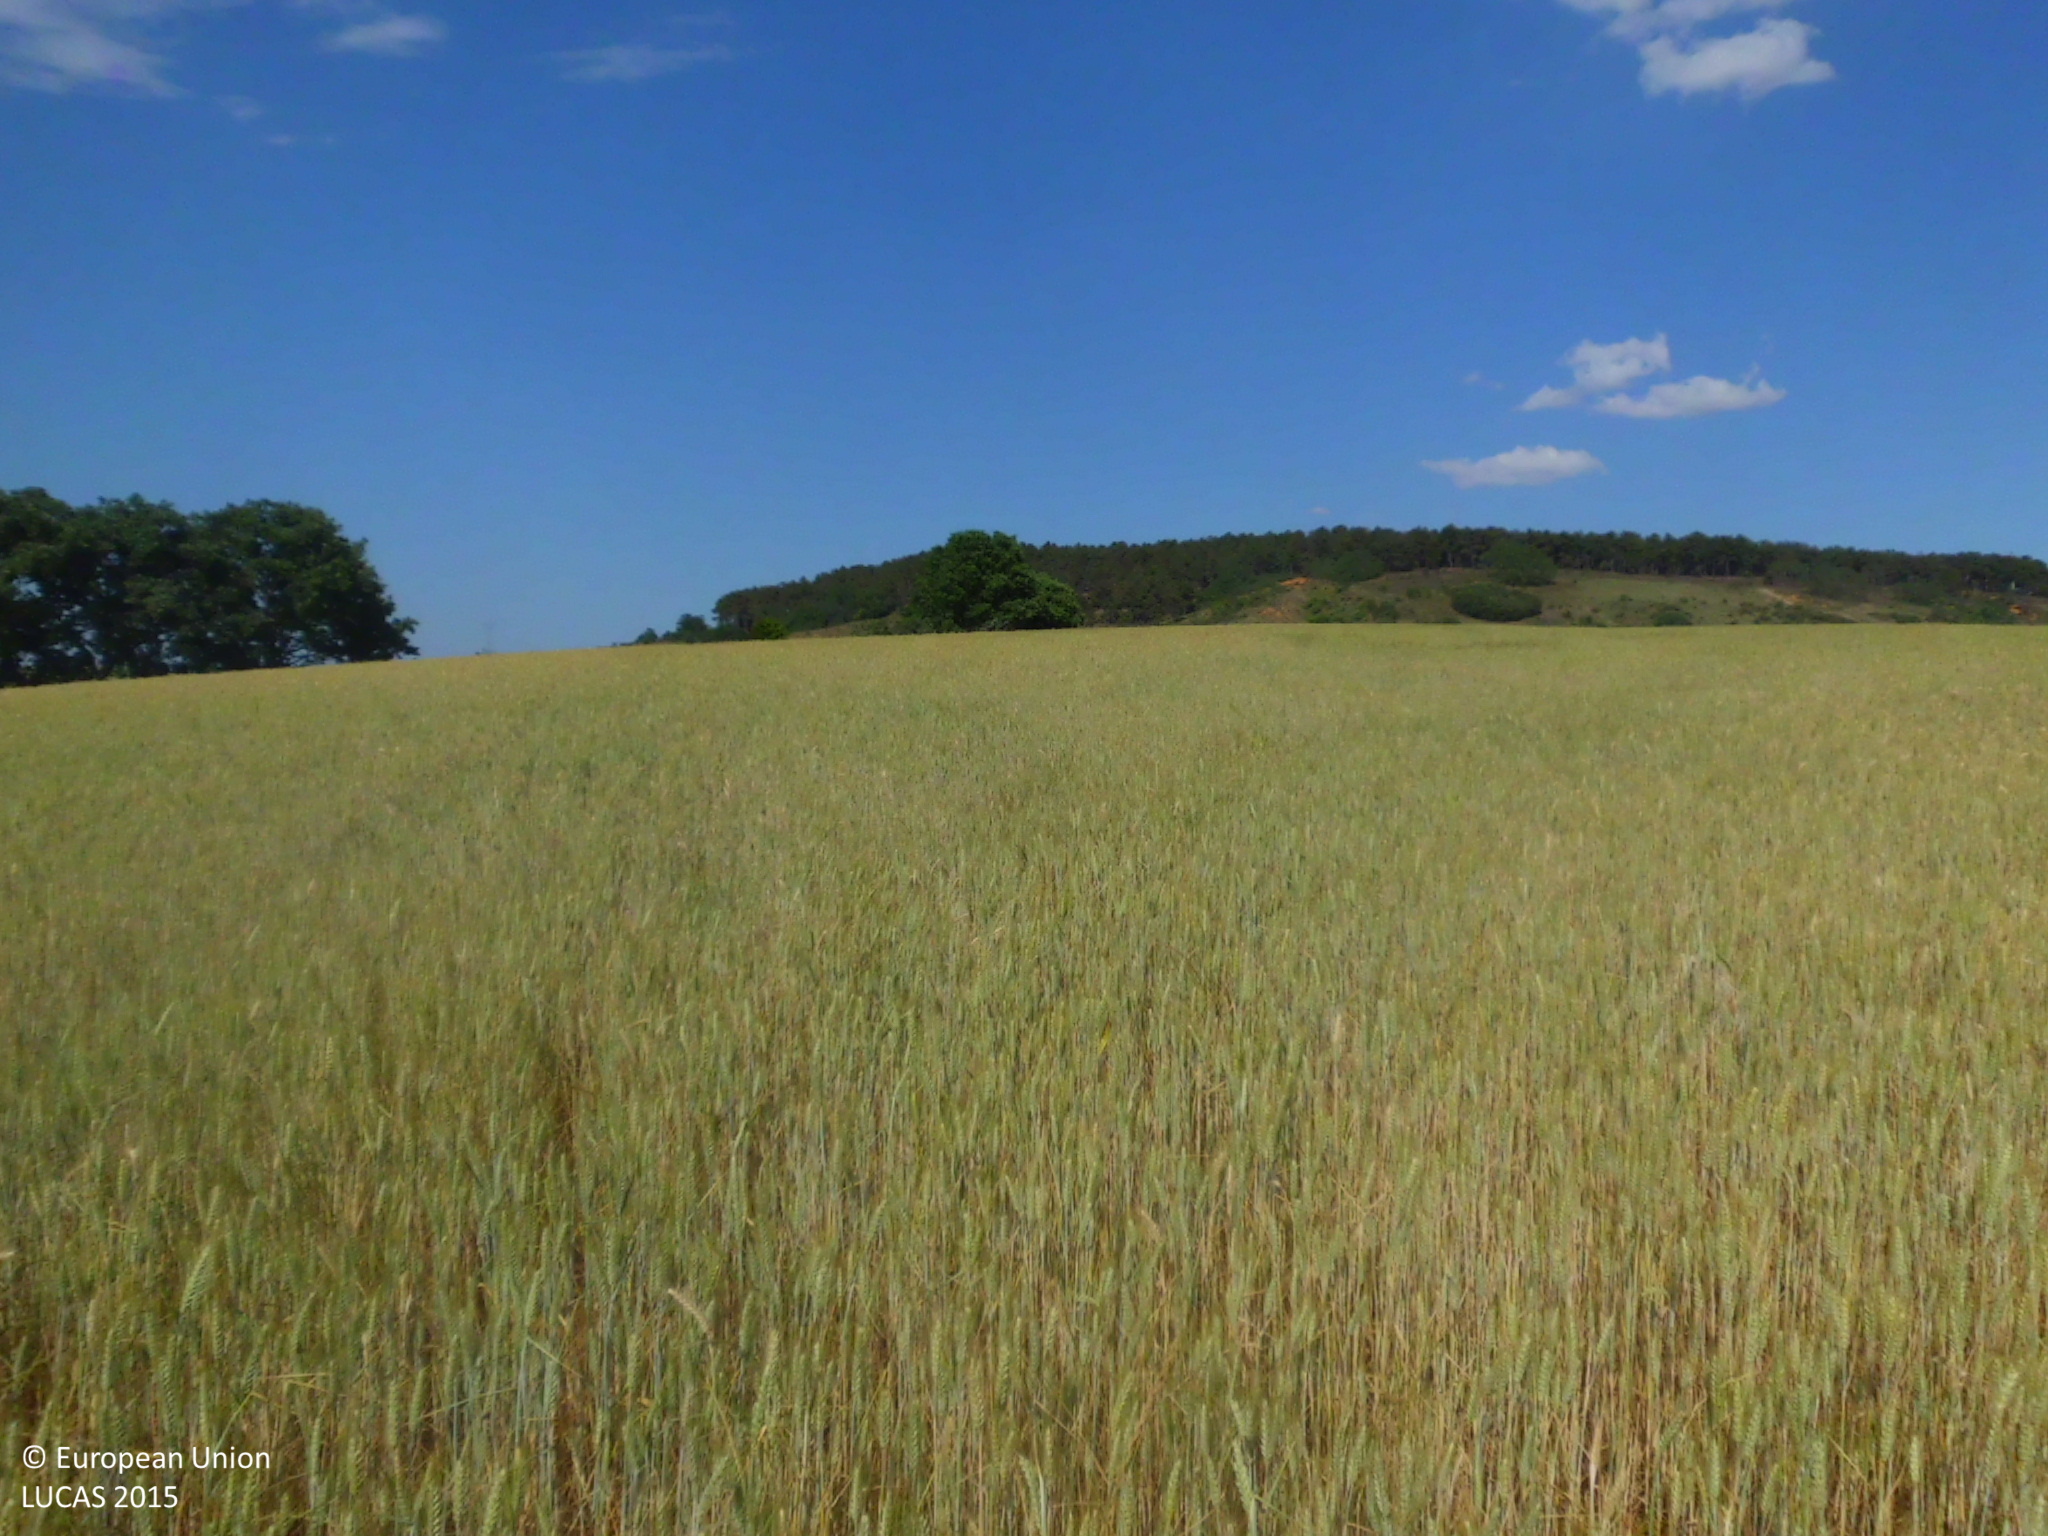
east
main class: Cropland
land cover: Common wheat
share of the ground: > 75 %
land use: Agriculture (excluding fallow land and kitchen gardens)
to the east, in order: Common wheat; Shrubland with sparse tree cover; Common wheat; Shrubland without tree cover
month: June
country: ES
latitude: 42.4878
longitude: -4.3434
